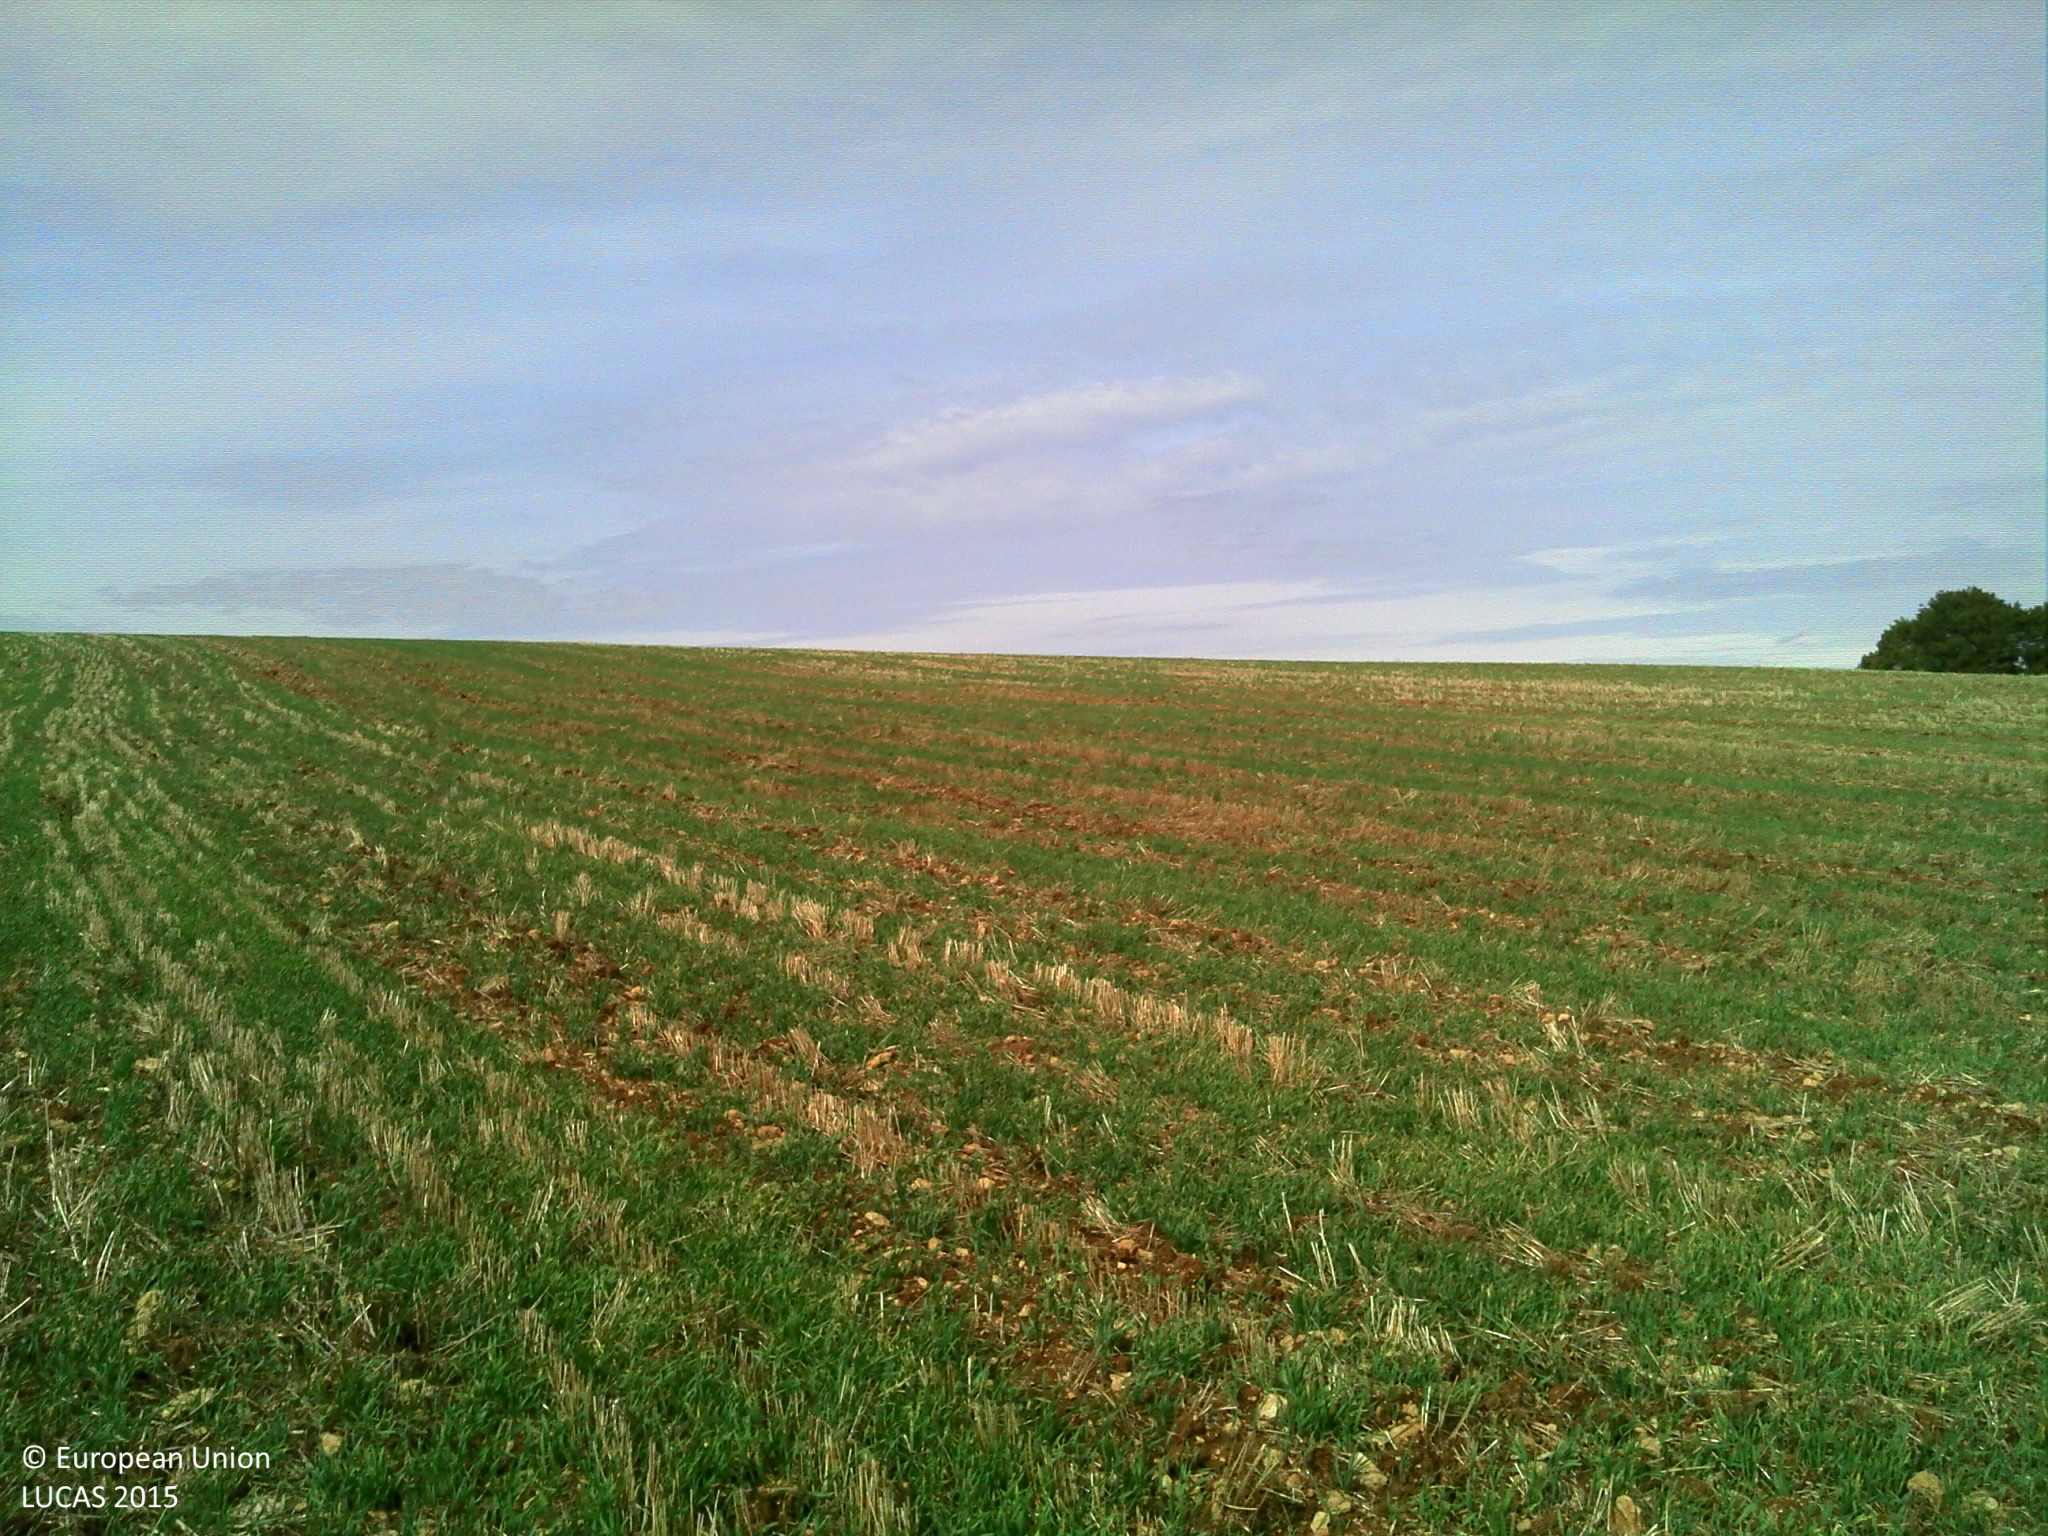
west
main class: Cropland
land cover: Barley
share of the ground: > 75 %
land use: Agriculture (excluding fallow land and kitchen gardens)
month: August
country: FR
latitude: 47.6727
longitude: 4.8985
